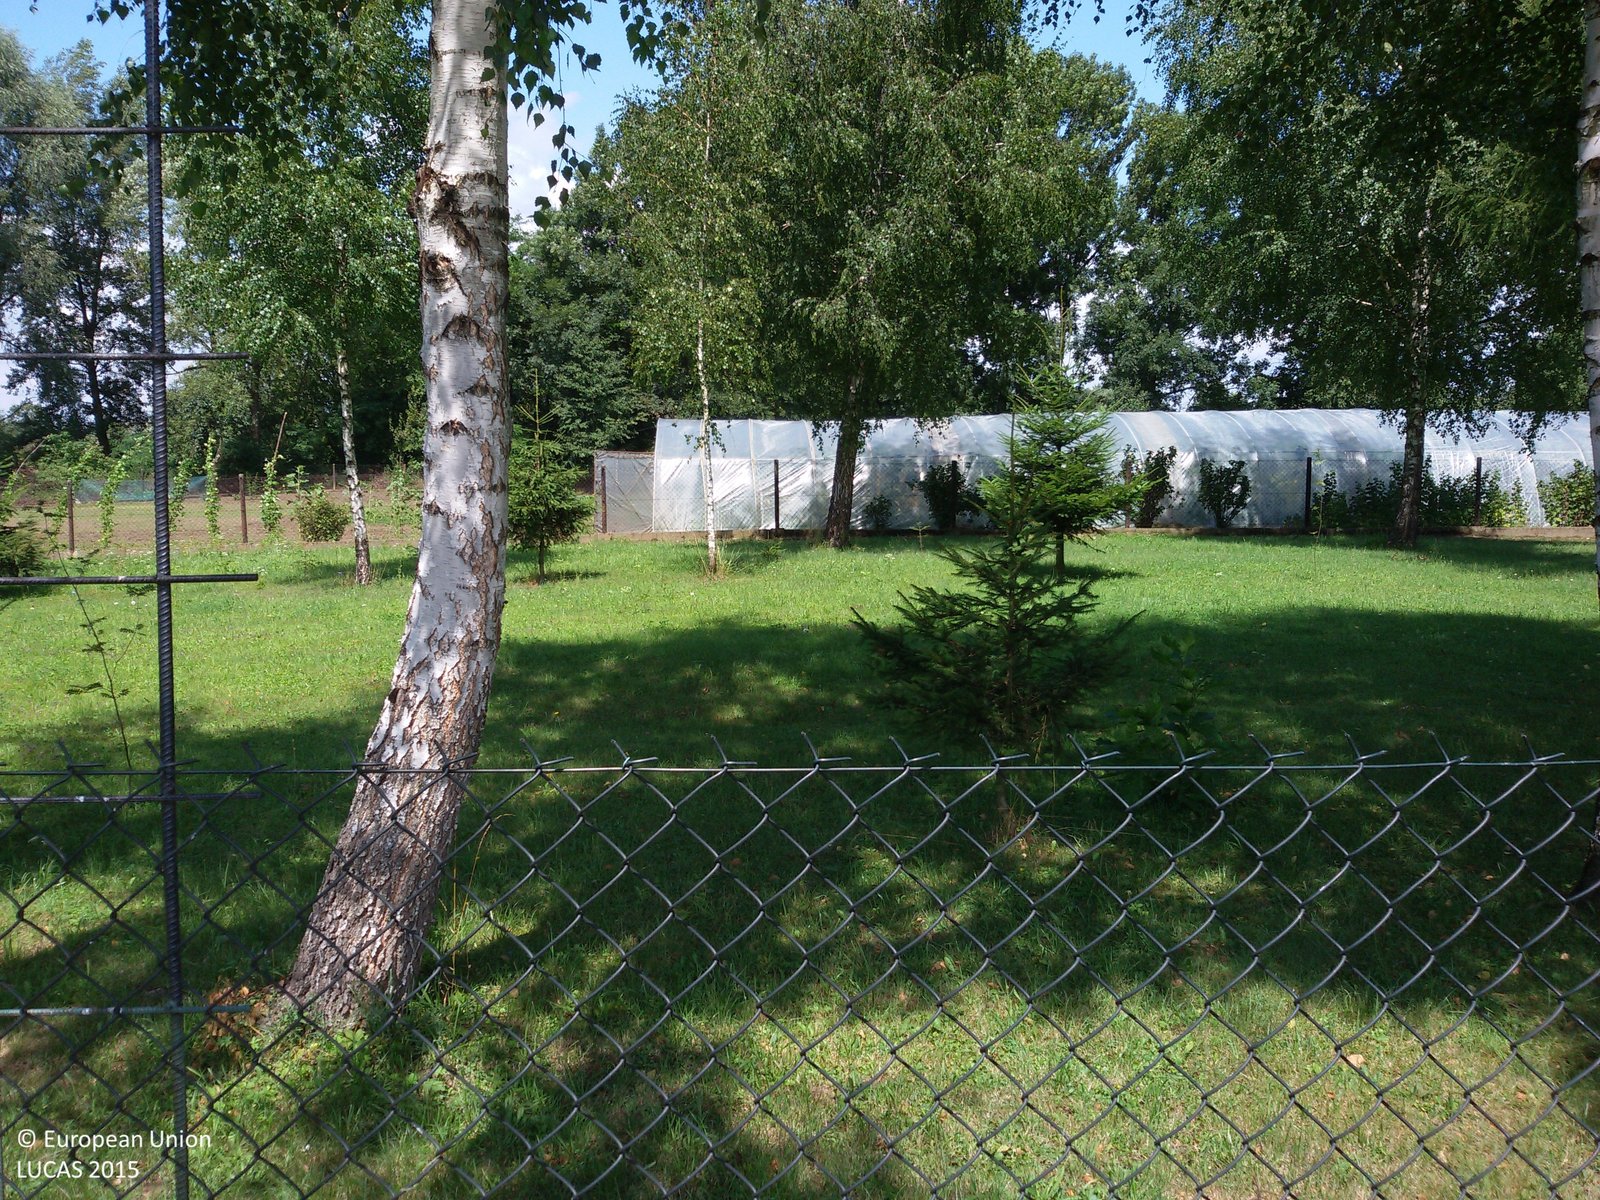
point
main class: Woodland
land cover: Broadleaved woodland
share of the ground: 10 - 25 %
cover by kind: herbaceous plants 80 %, broadleaved forest trees 15 %, coniferous forest trees 5 %
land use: Residential
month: July
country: PL
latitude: 49.9515
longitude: 20.3070
